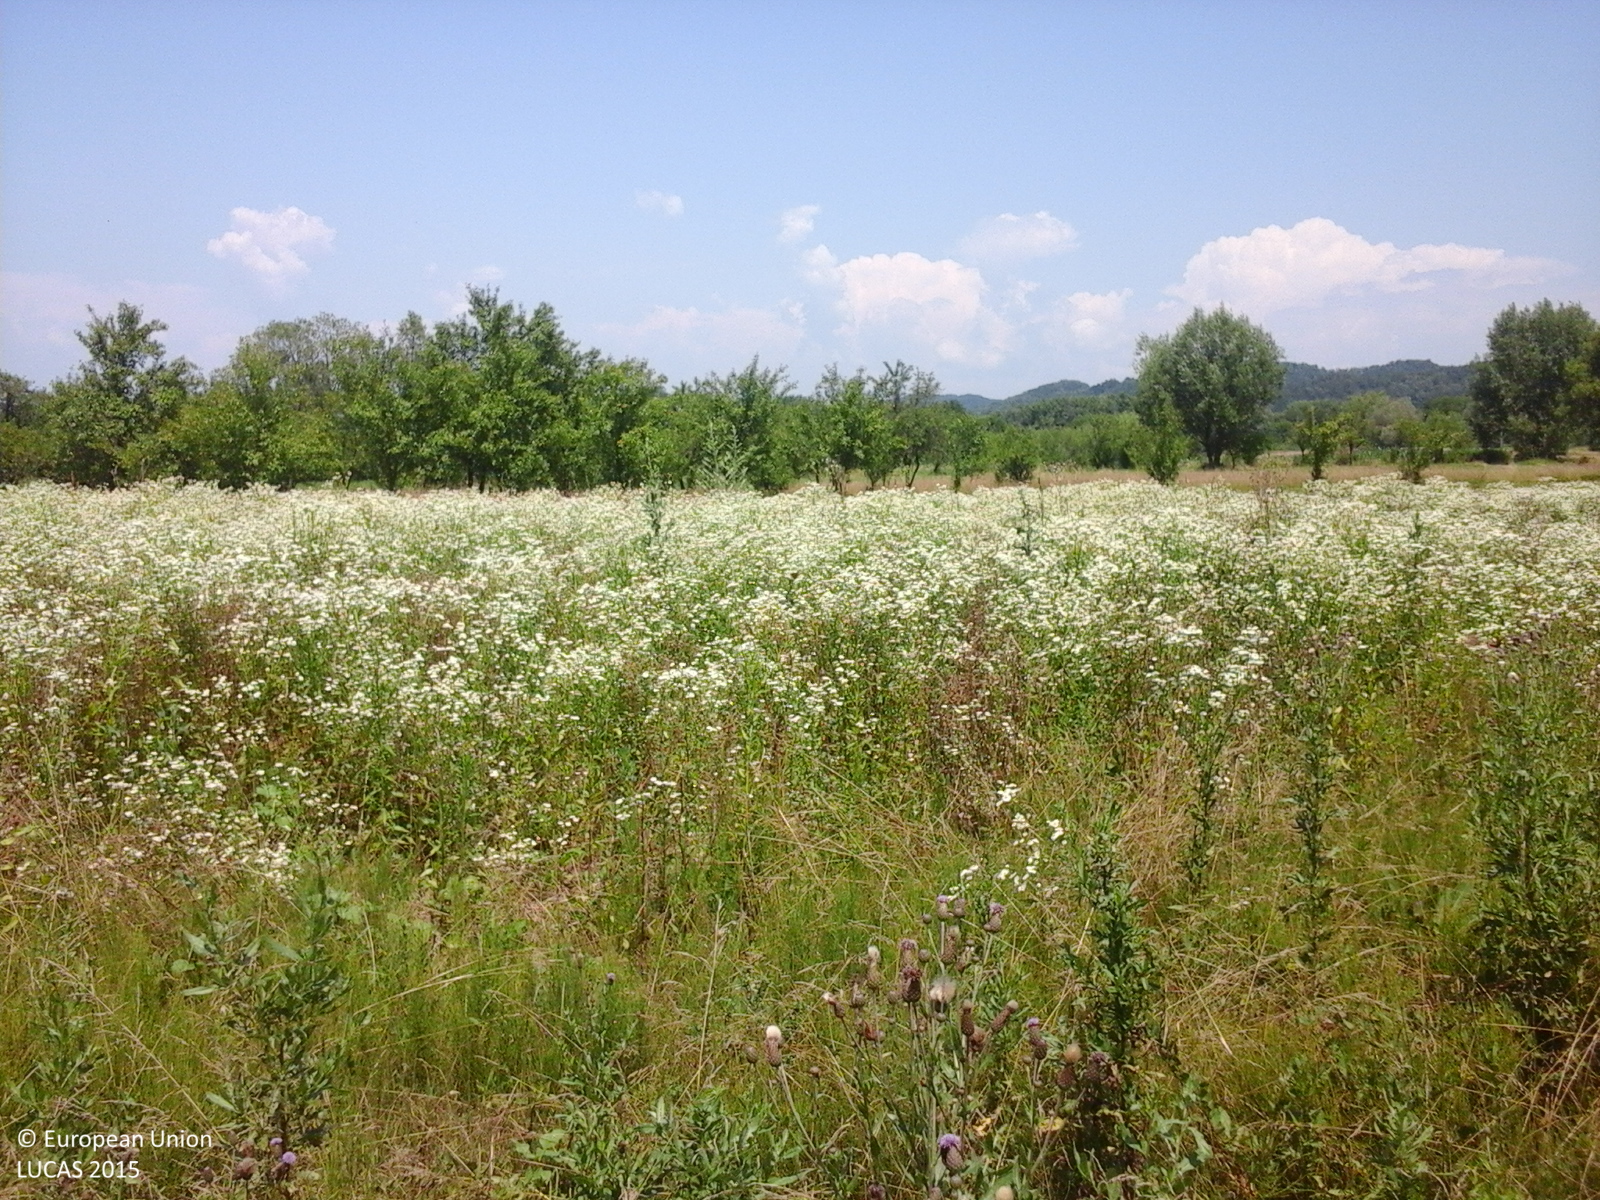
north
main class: Grassland
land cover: Spontaneously vegetated surfaces
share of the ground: > 75 %
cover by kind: herbaceous plants 100 %
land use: Agriculture (excluding fallow land and kitchen gardens)
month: July
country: RO
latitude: 45.0477
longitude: 24.8747
